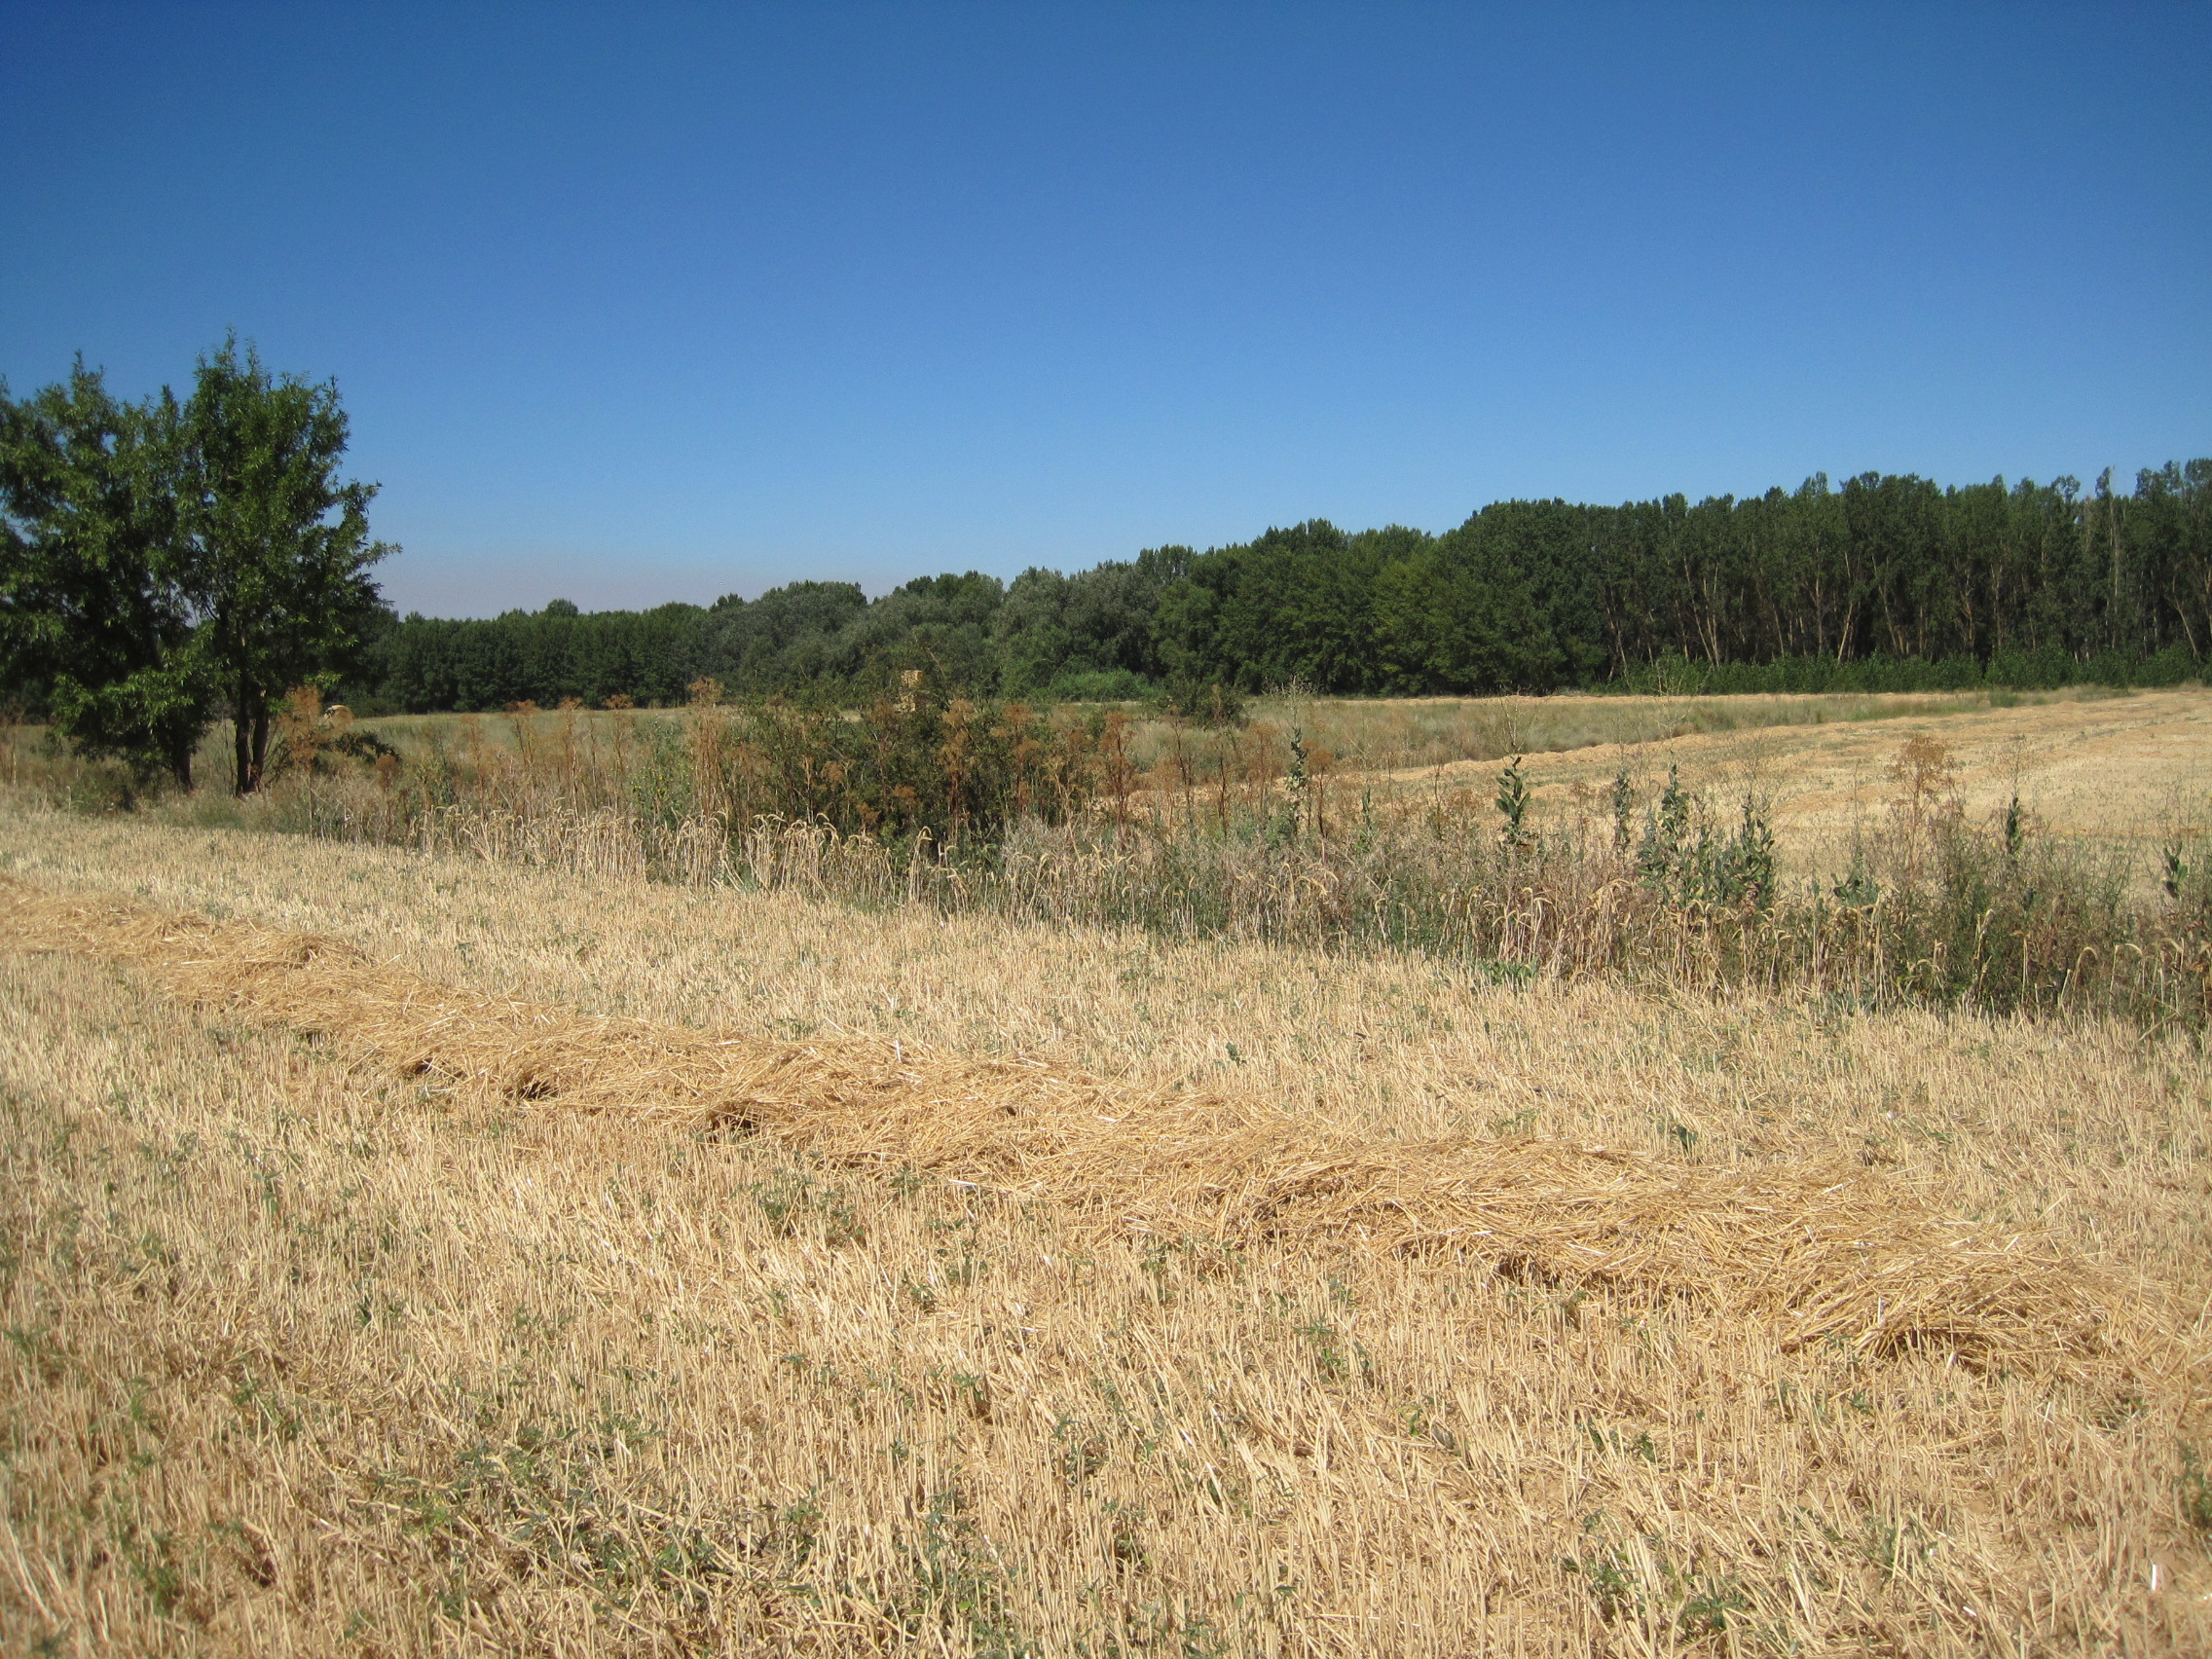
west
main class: Cropland
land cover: Common wheat
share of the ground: < 10 %
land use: Agriculture (excluding fallow land and kitchen gardens)
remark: Harvested field
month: July
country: ES
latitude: 42.1448
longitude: -5.2960
